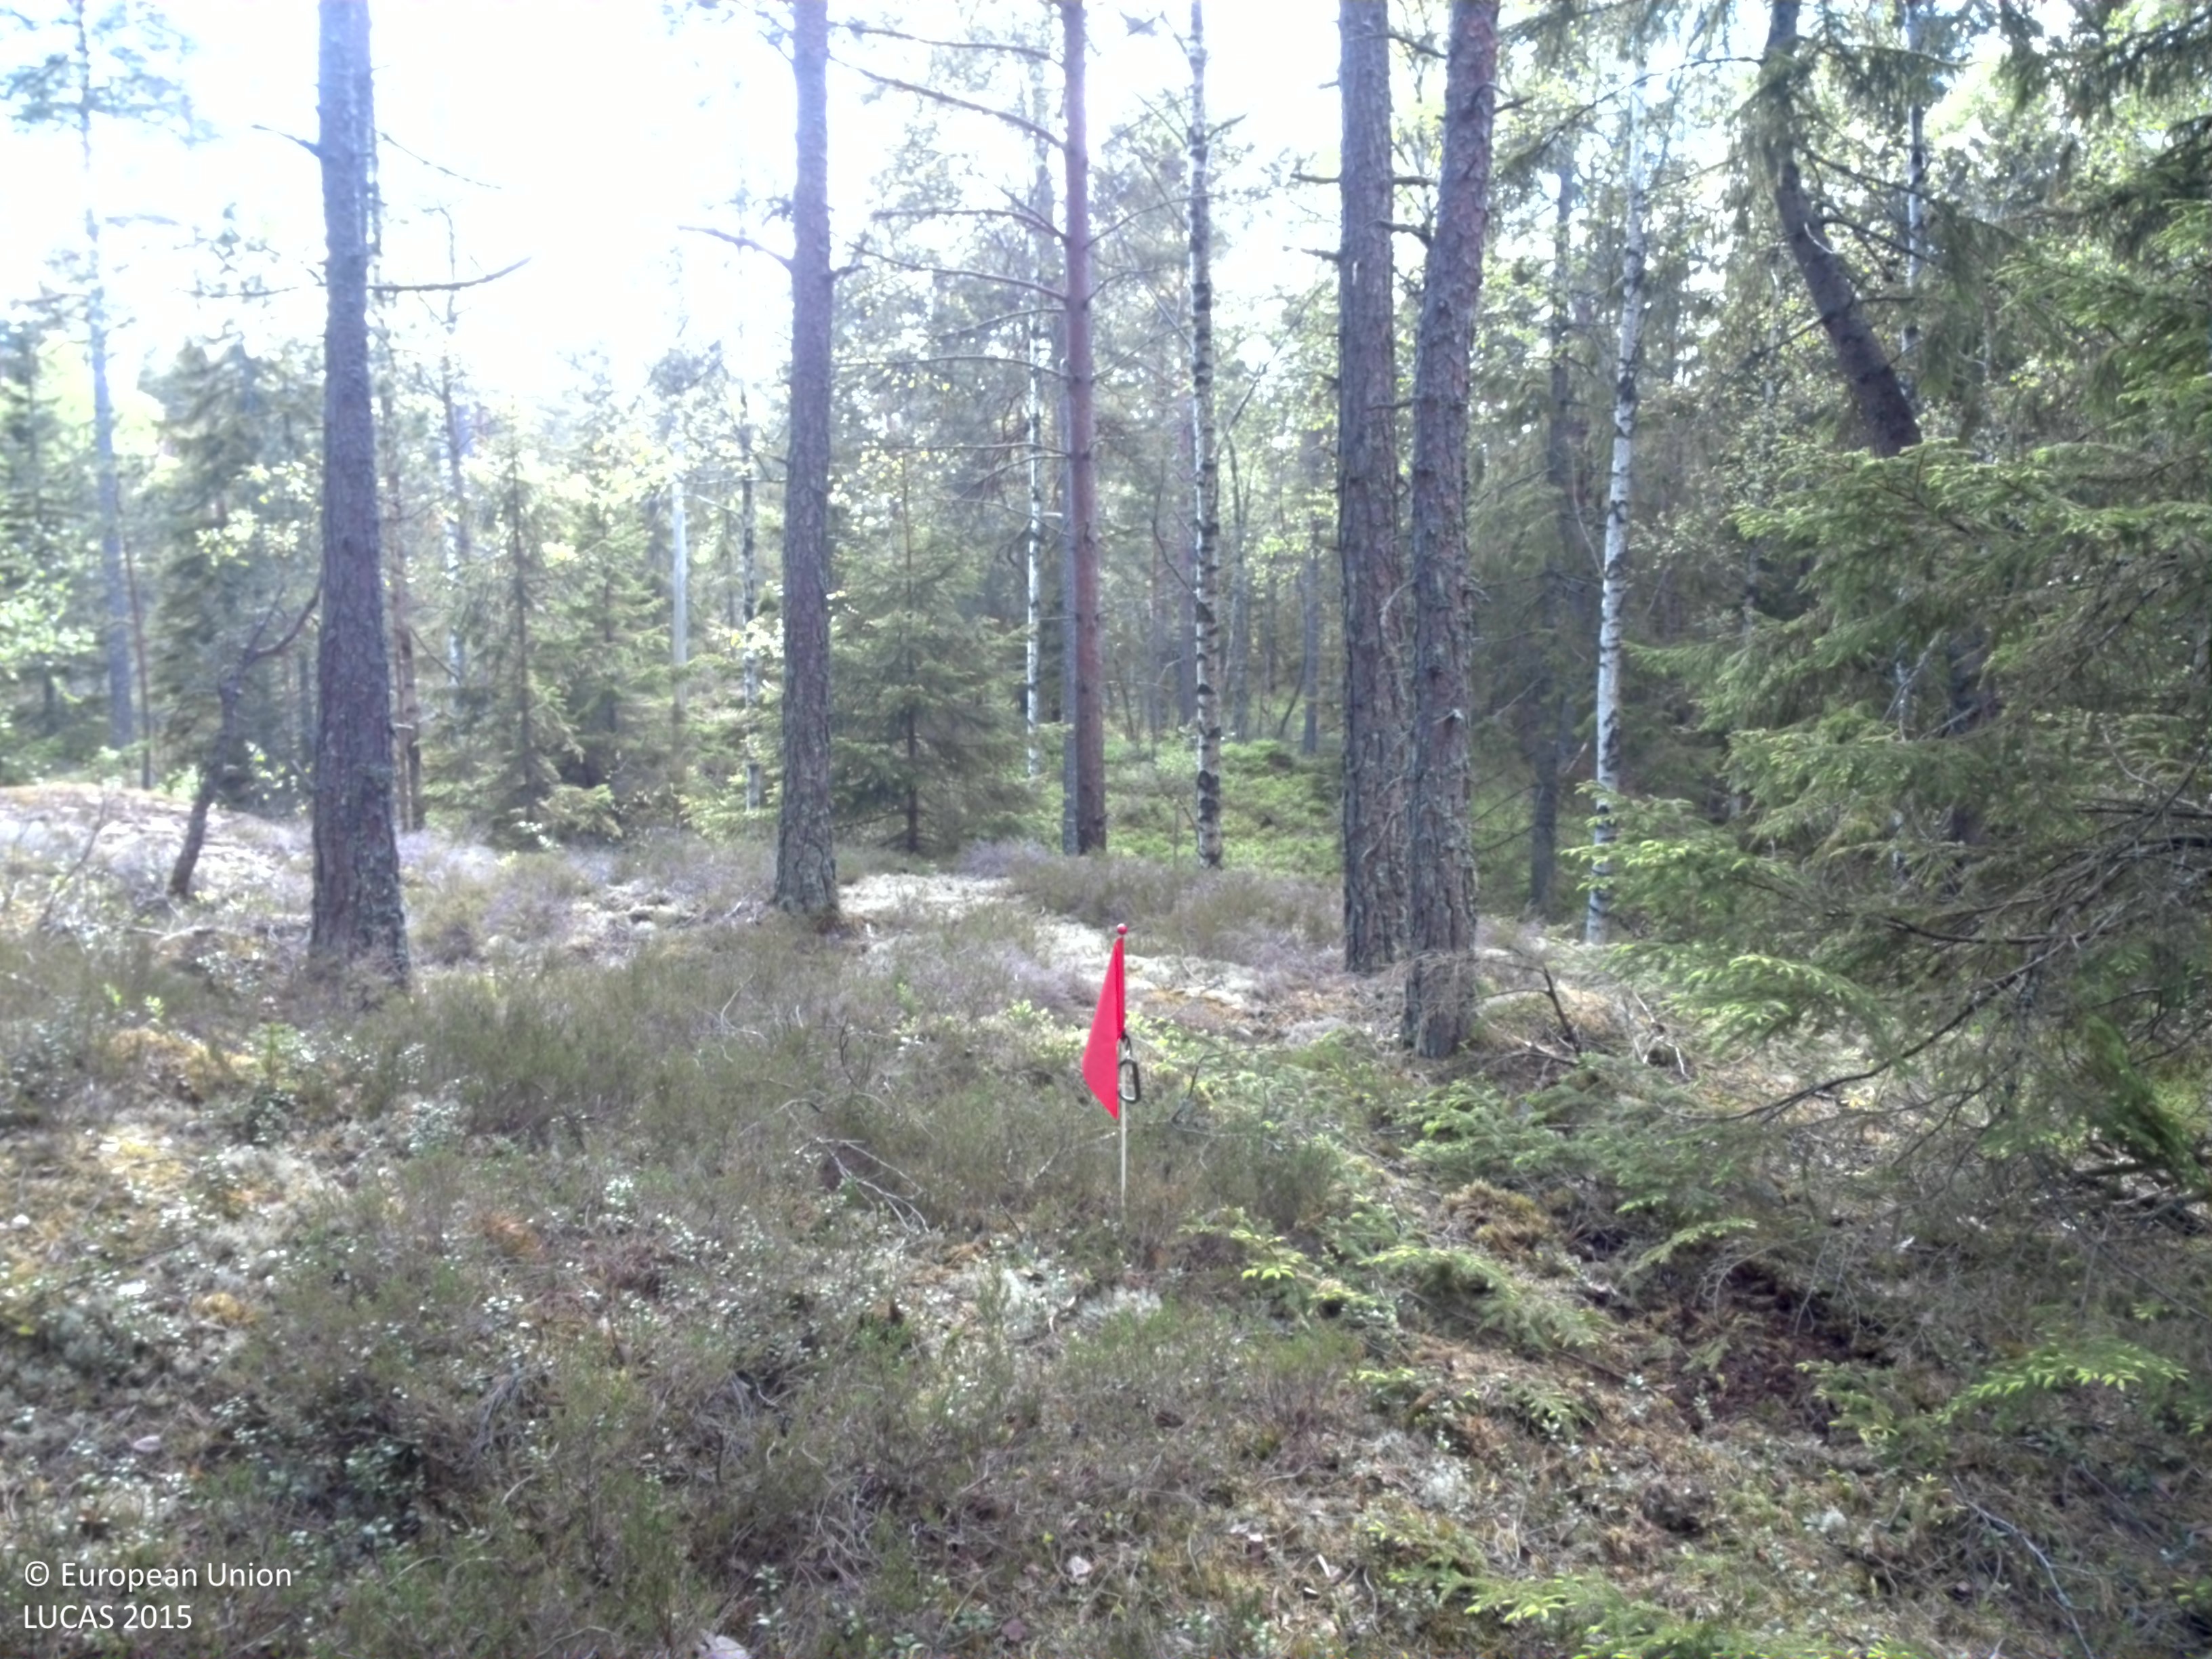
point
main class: Woodland
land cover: Spruce dominated coniferous woodland
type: boreal forest
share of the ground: > 75 %
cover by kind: coniferous forest trees 80 %, herbaceous plants 20 %
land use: Forestry
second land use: Amenities, museums, leisure
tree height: > 5 m
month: May
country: SE
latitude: 58.4156
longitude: 12.3064
